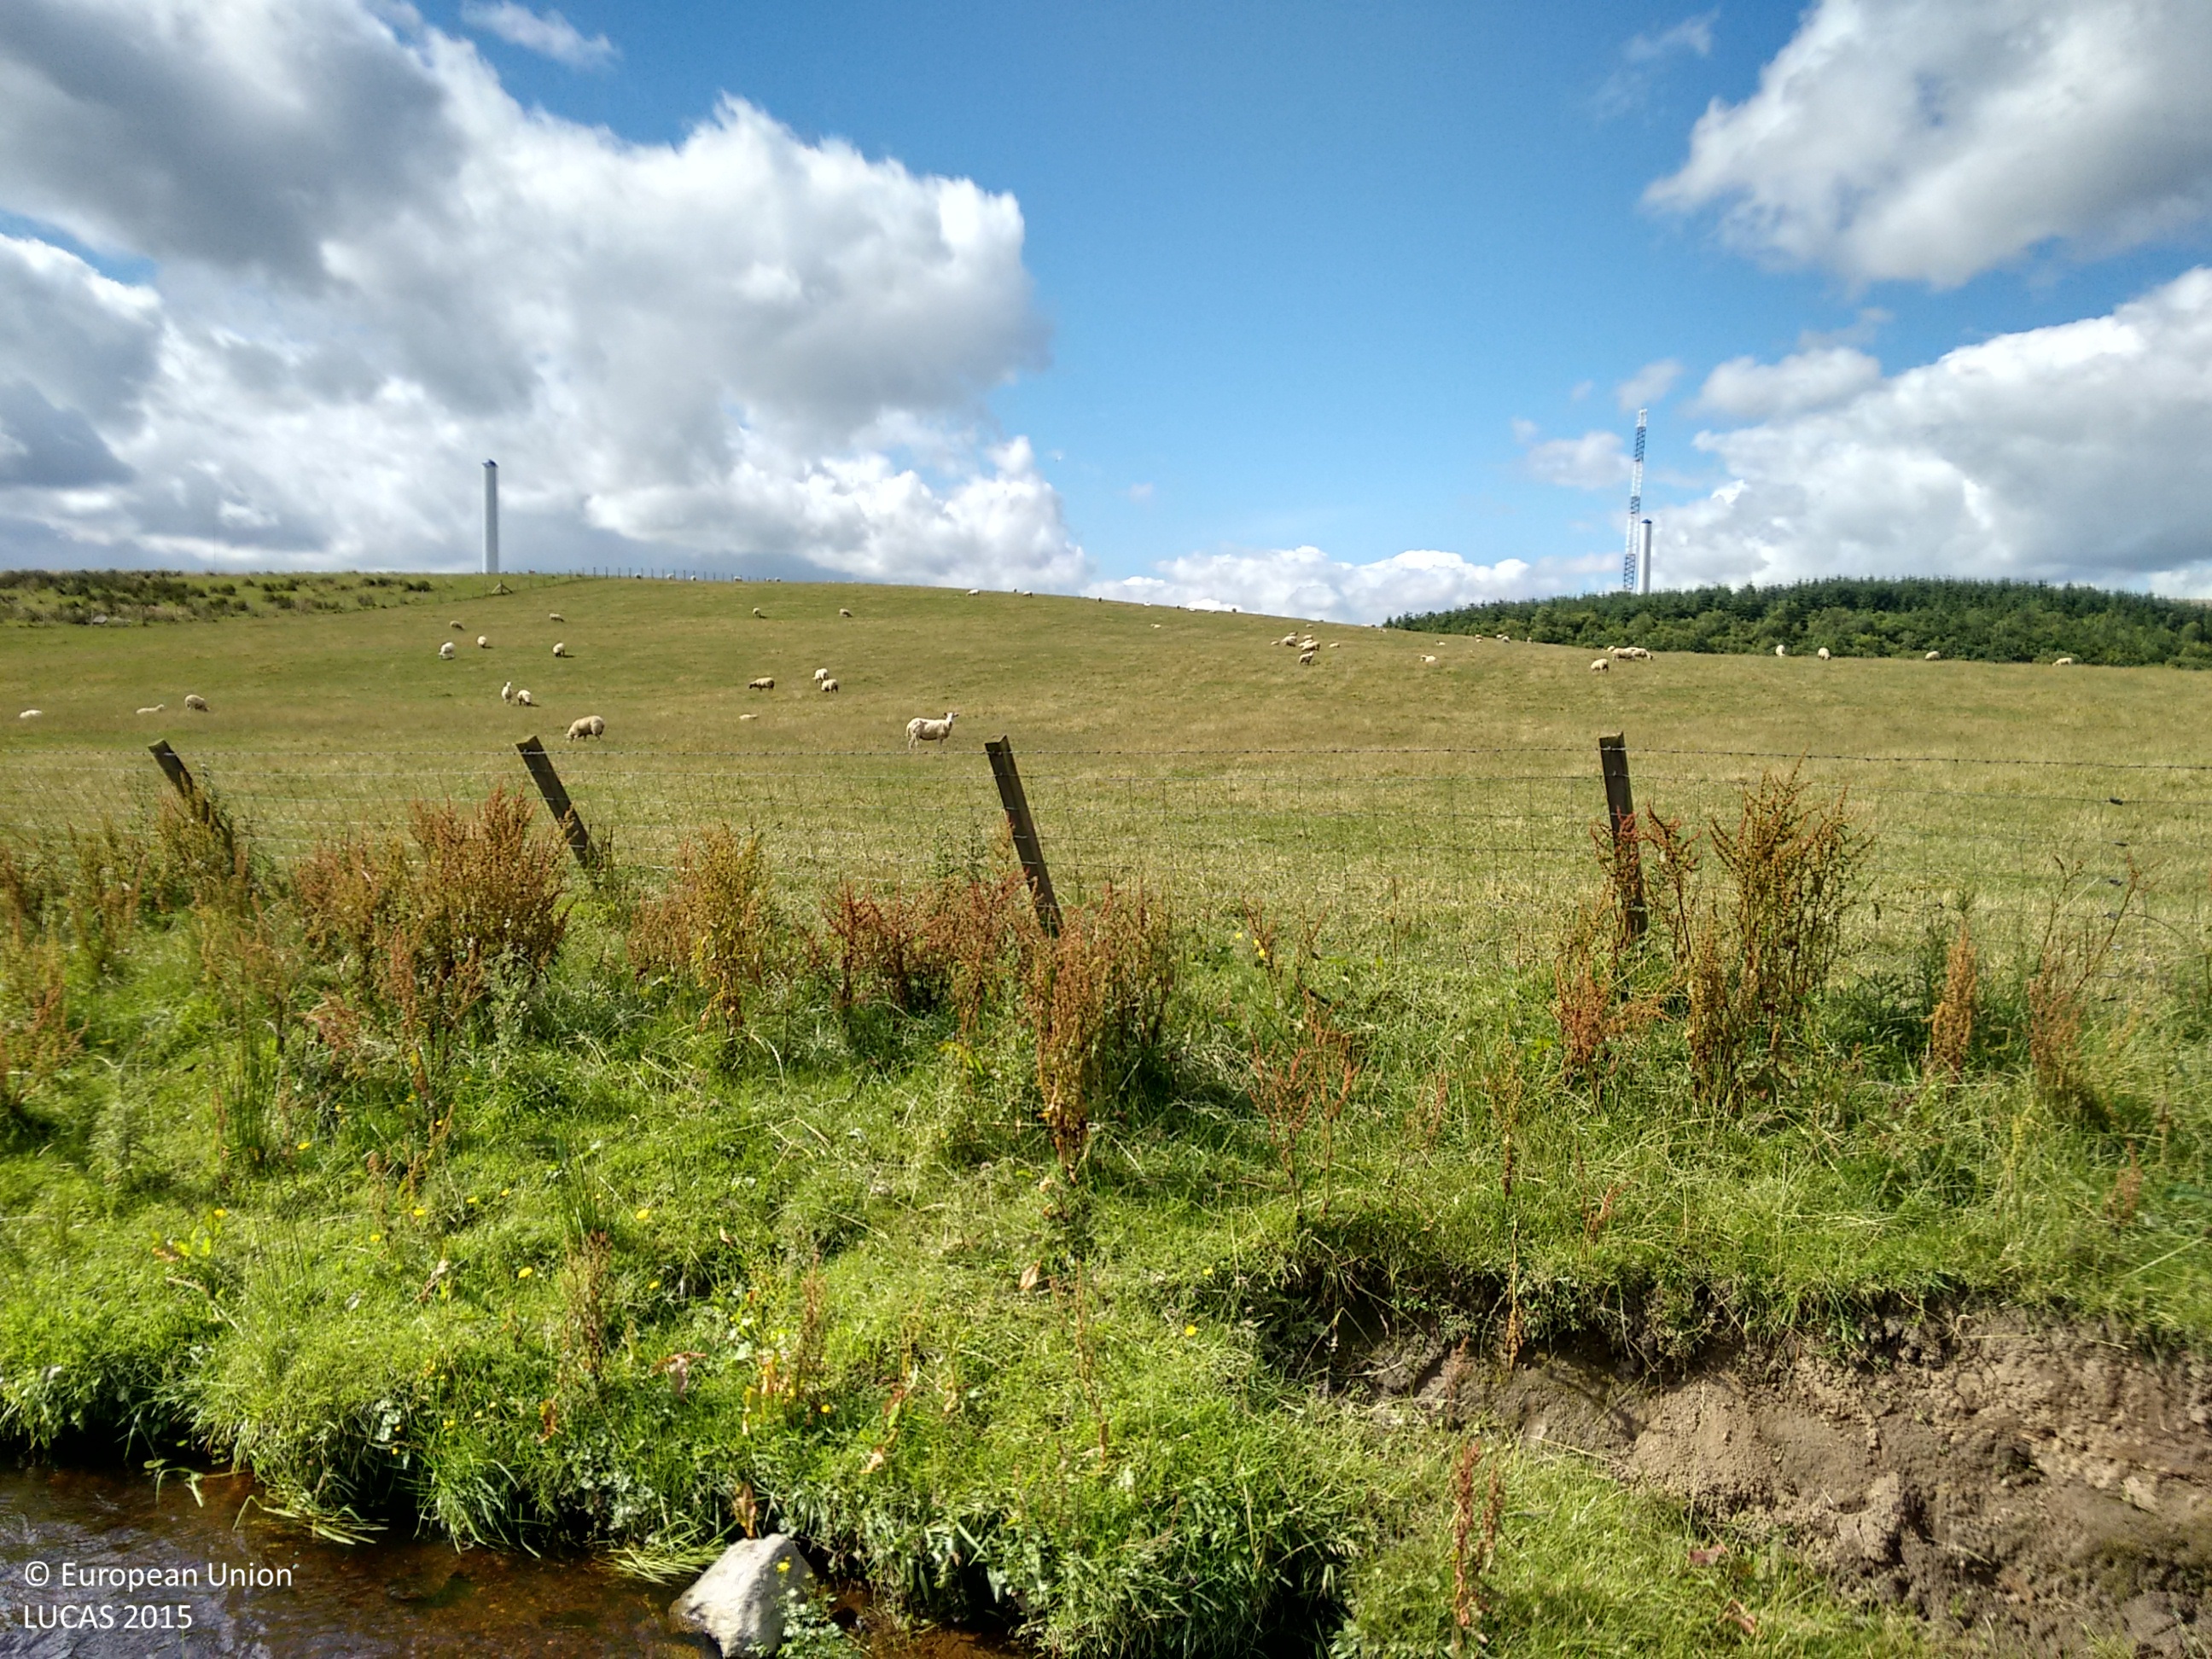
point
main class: Grassland
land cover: Grassland without tree/shrub cover
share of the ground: > 75 %
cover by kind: herbaceous plants 100 %
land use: Agriculture (excluding fallow land and kitchen gardens)
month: August
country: GB
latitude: 55.9164
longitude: -3.7628
